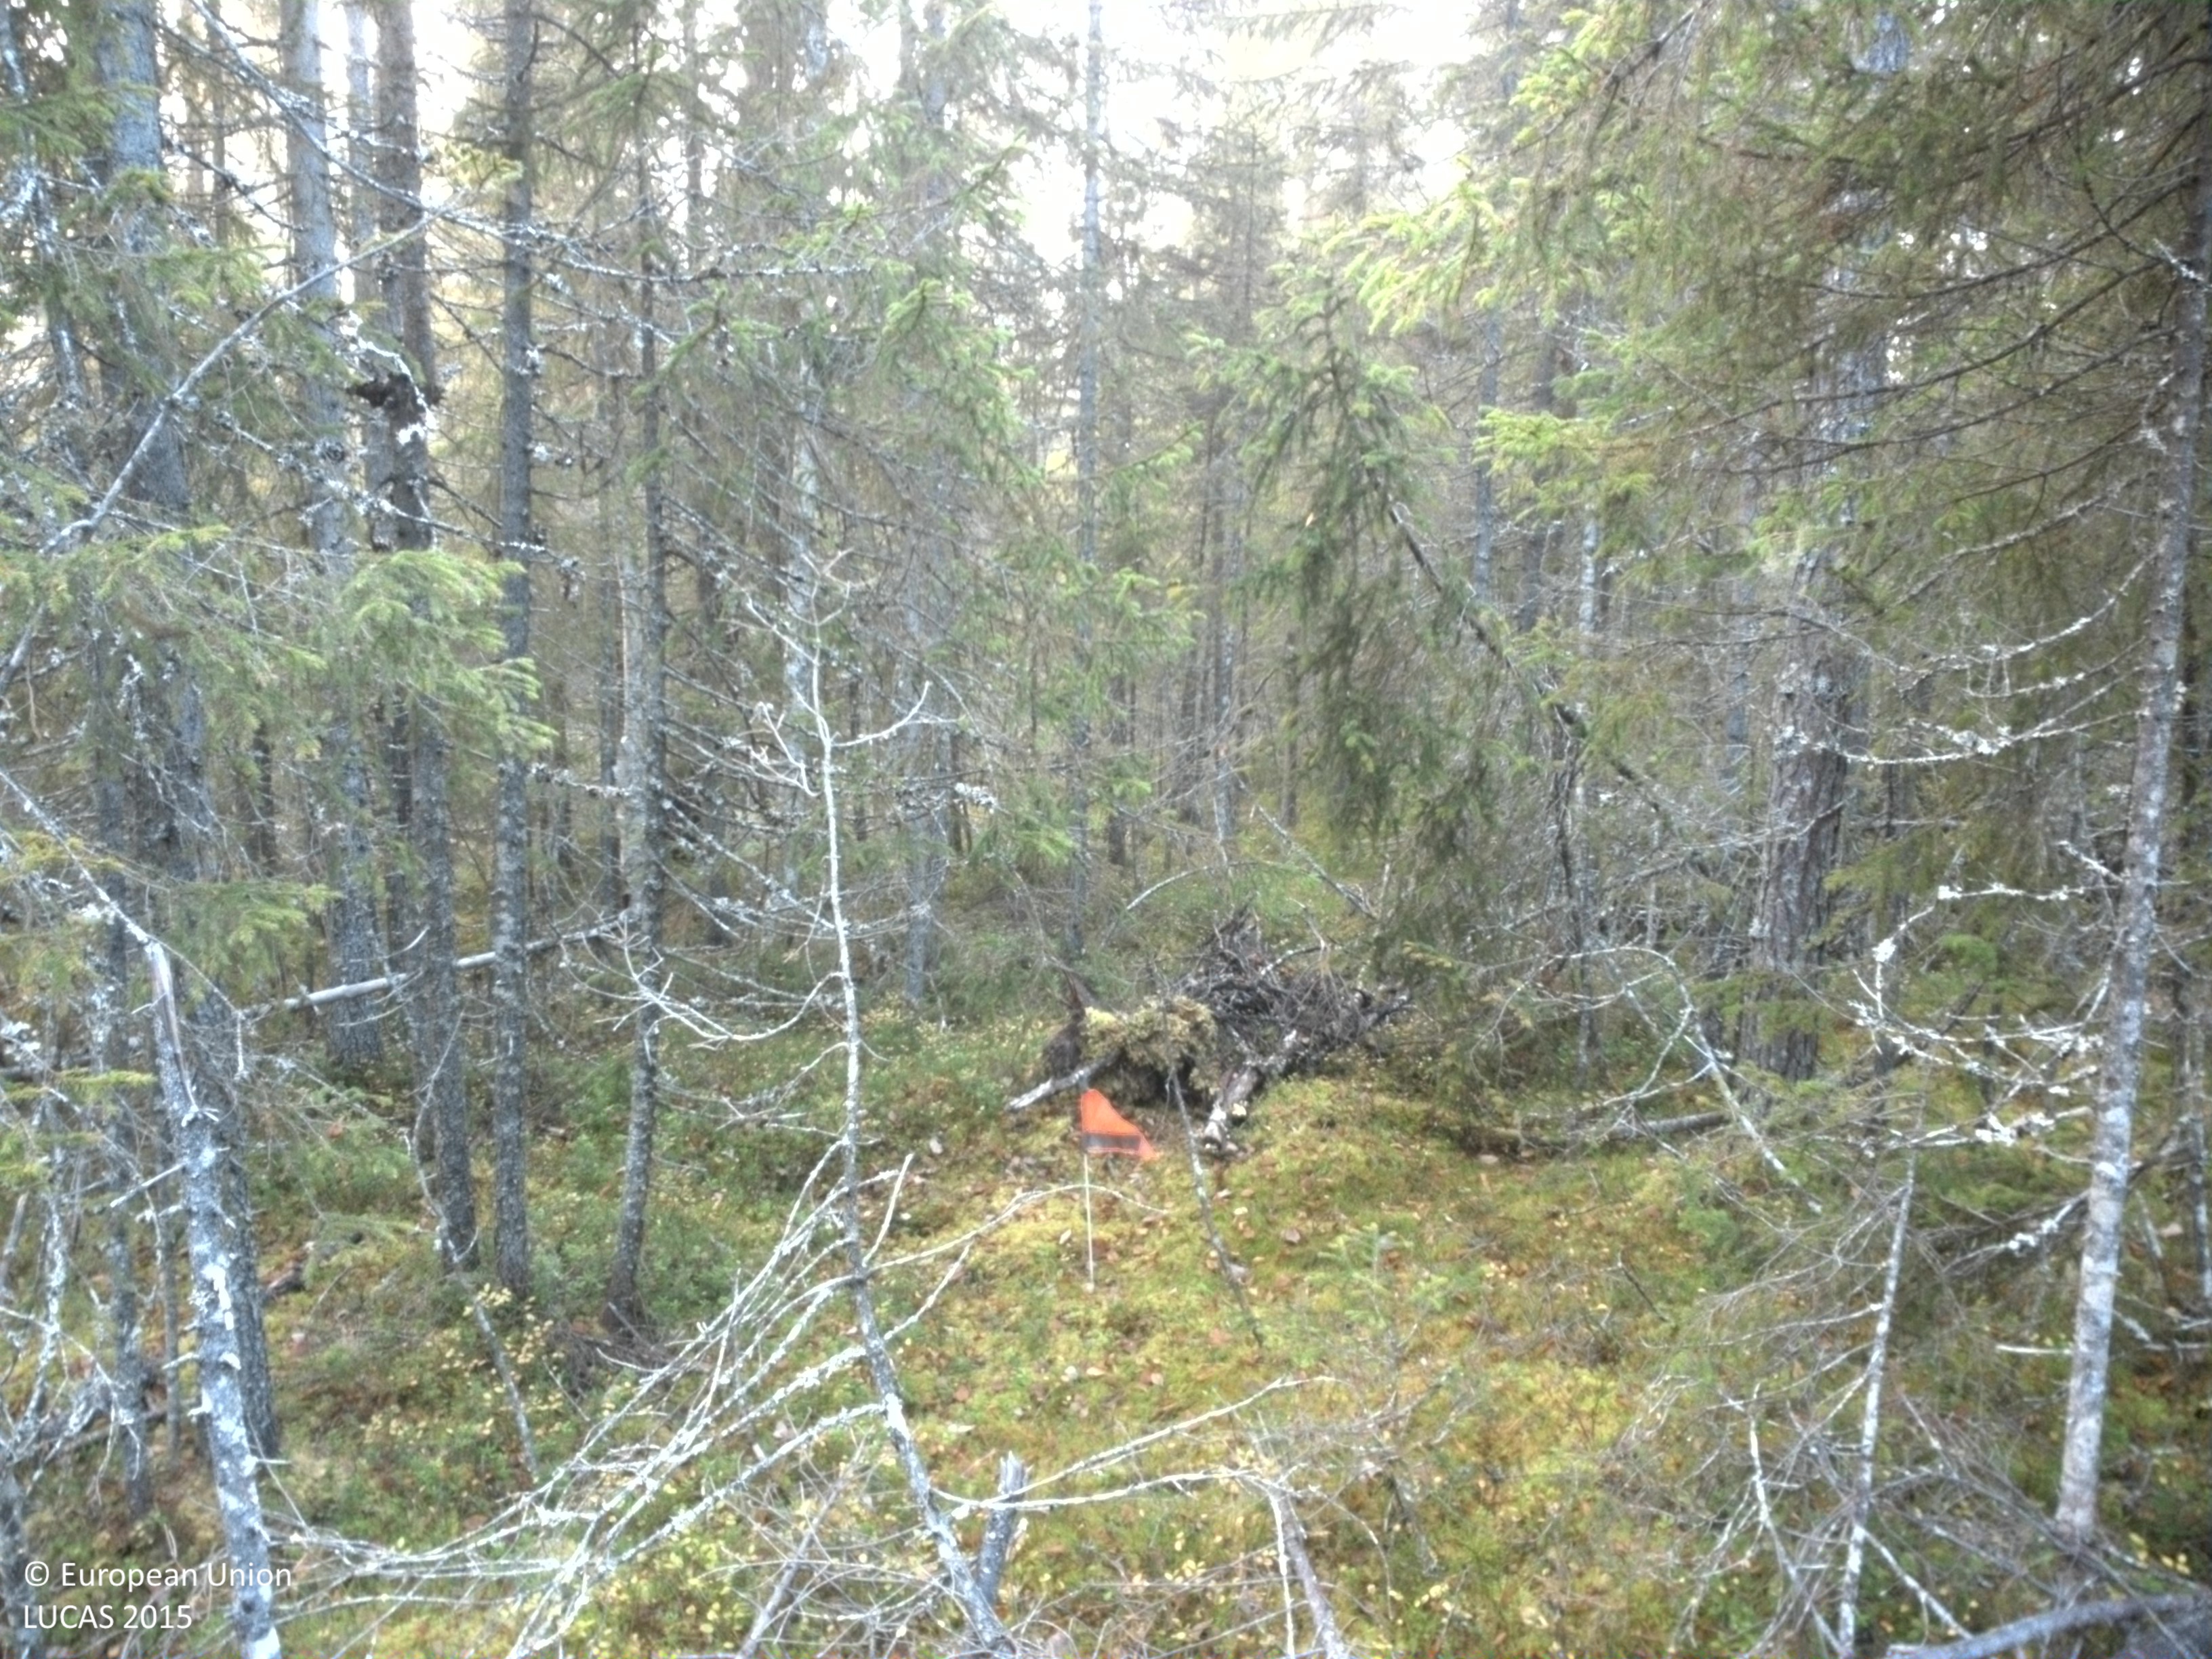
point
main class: Woodland
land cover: Spruce dominated coniferous woodland
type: boreal forest
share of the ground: 50 - 75 %
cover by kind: coniferous forest trees 65 %, shrubs 15 %, herbaceous plants 15 %, broadleaved forest trees 5 %
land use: Forestry
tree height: > 5 m
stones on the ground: < 10 %
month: October
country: SE
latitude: 64.5483
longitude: 16.6619
